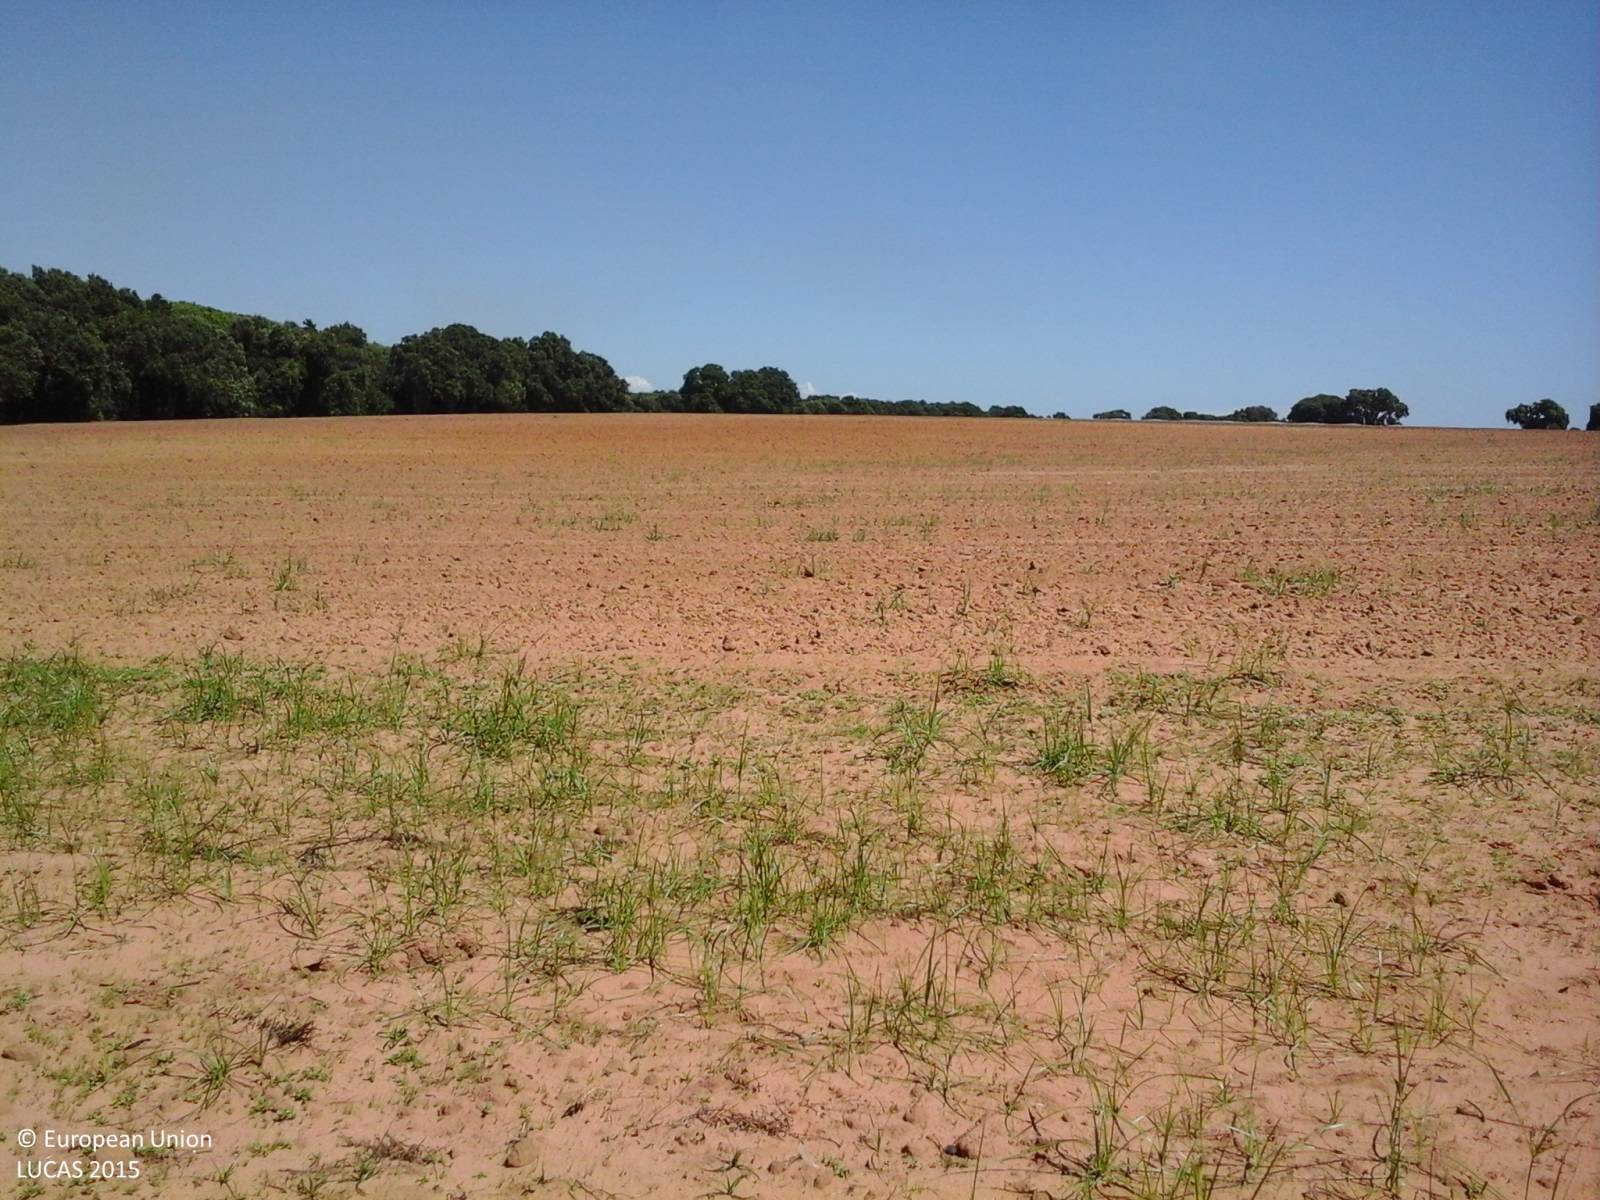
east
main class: Grassland
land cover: Spontaneously vegetated surfaces
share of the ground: > 75 %
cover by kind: herbaceous plants 100 %
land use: Agriculture (excluding fallow land and kitchen gardens)
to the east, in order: Spontaneously vegetated surfaces; Other bare soil; Other fresh vegetables
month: August
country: IT
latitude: 41.2698
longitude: 13.0553
